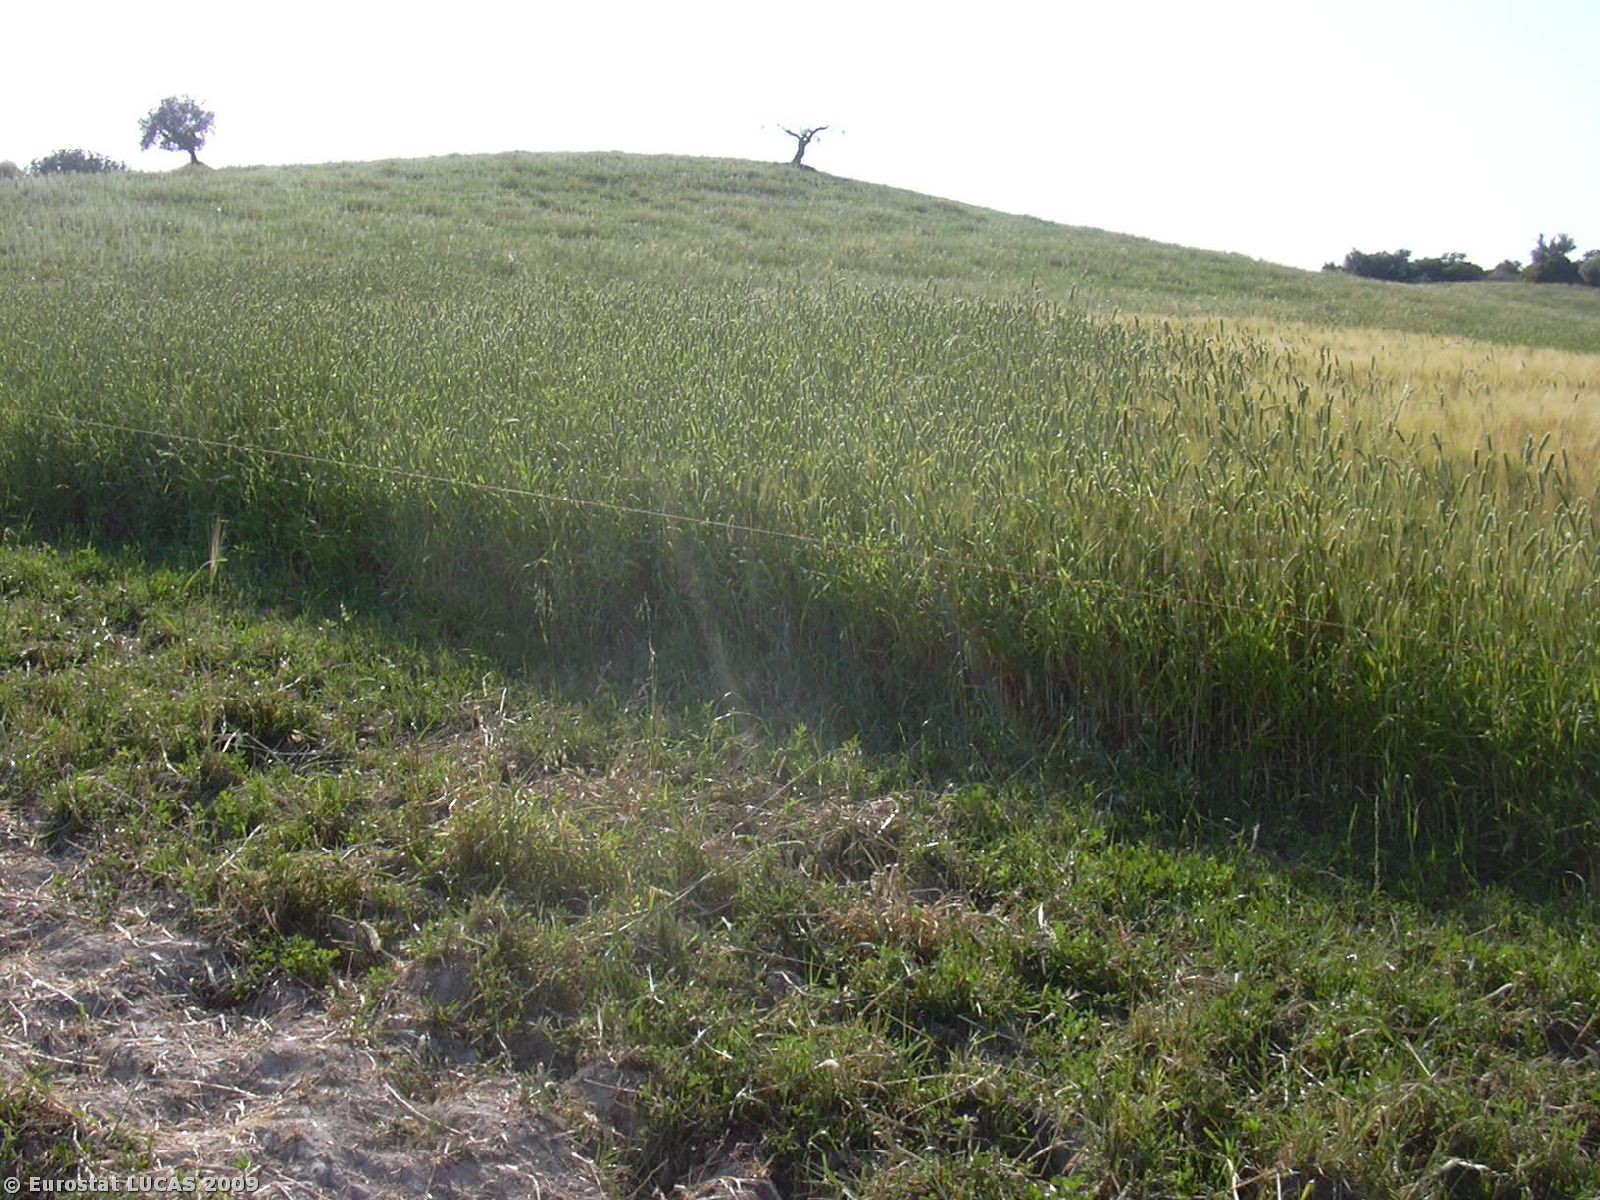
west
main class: Cropland
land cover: Mixed cereals for fodder
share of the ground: 50 - 75 %
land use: Agriculture (excluding fallow land and kitchen gardens)
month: May
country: IT
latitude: 36.9667
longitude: 14.8926
